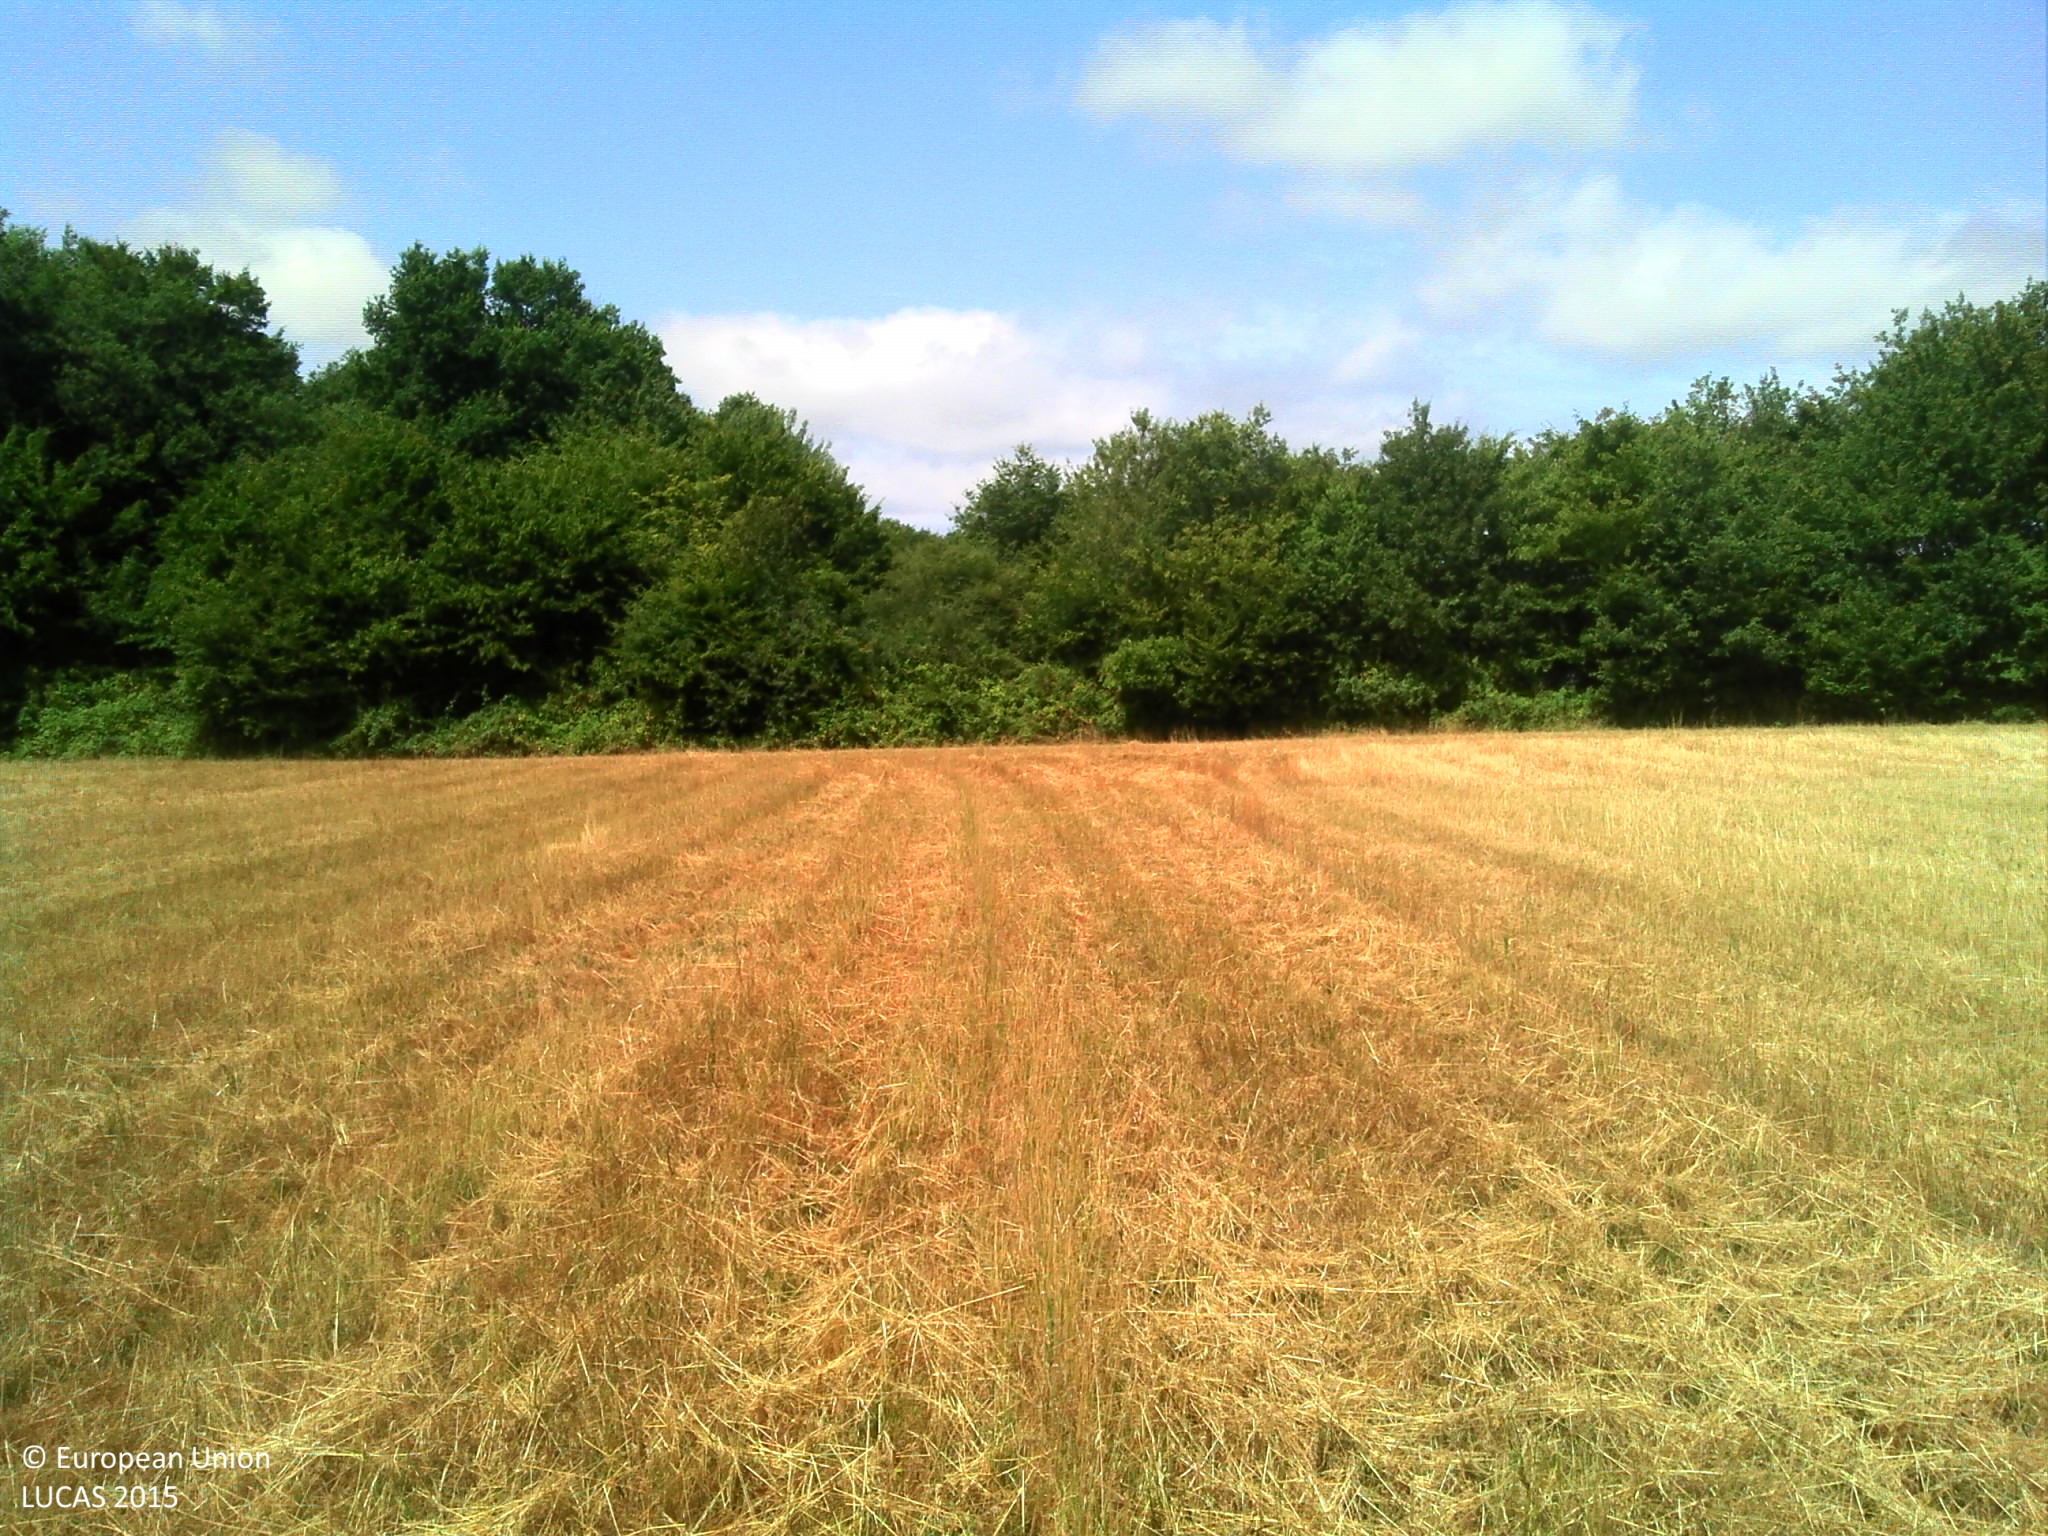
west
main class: Grassland
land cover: Grassland without tree/shrub cover
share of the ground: > 75 %
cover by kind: herbaceous plants 100 %
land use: Agriculture (excluding fallow land and kitchen gardens)
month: July
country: FR
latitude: 47.1822
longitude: 0.5450
